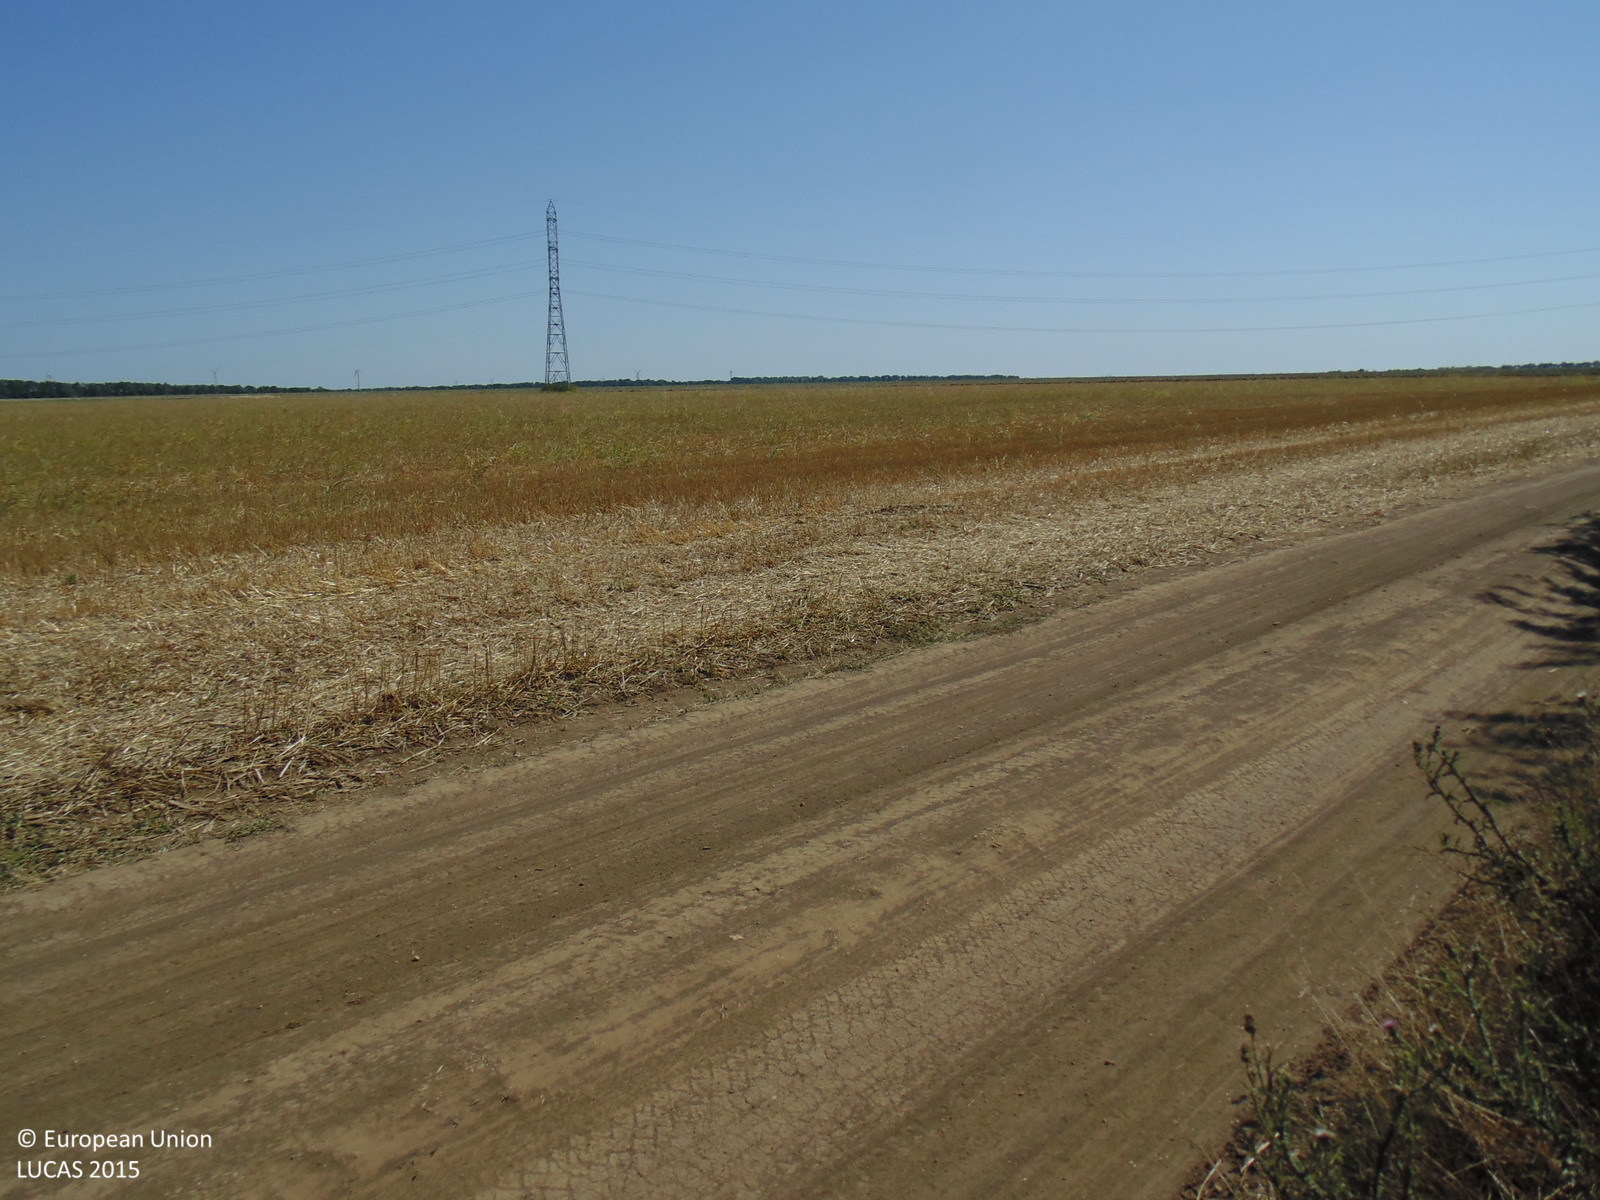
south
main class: Woodland
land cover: Broadleaved woodland
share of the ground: > 75 %
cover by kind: broadleaved forest trees 90 %, herbaceous plants 10 %
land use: Forestry
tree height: > 5 m
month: August
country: BG
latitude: 43.5089
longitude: 28.2495
